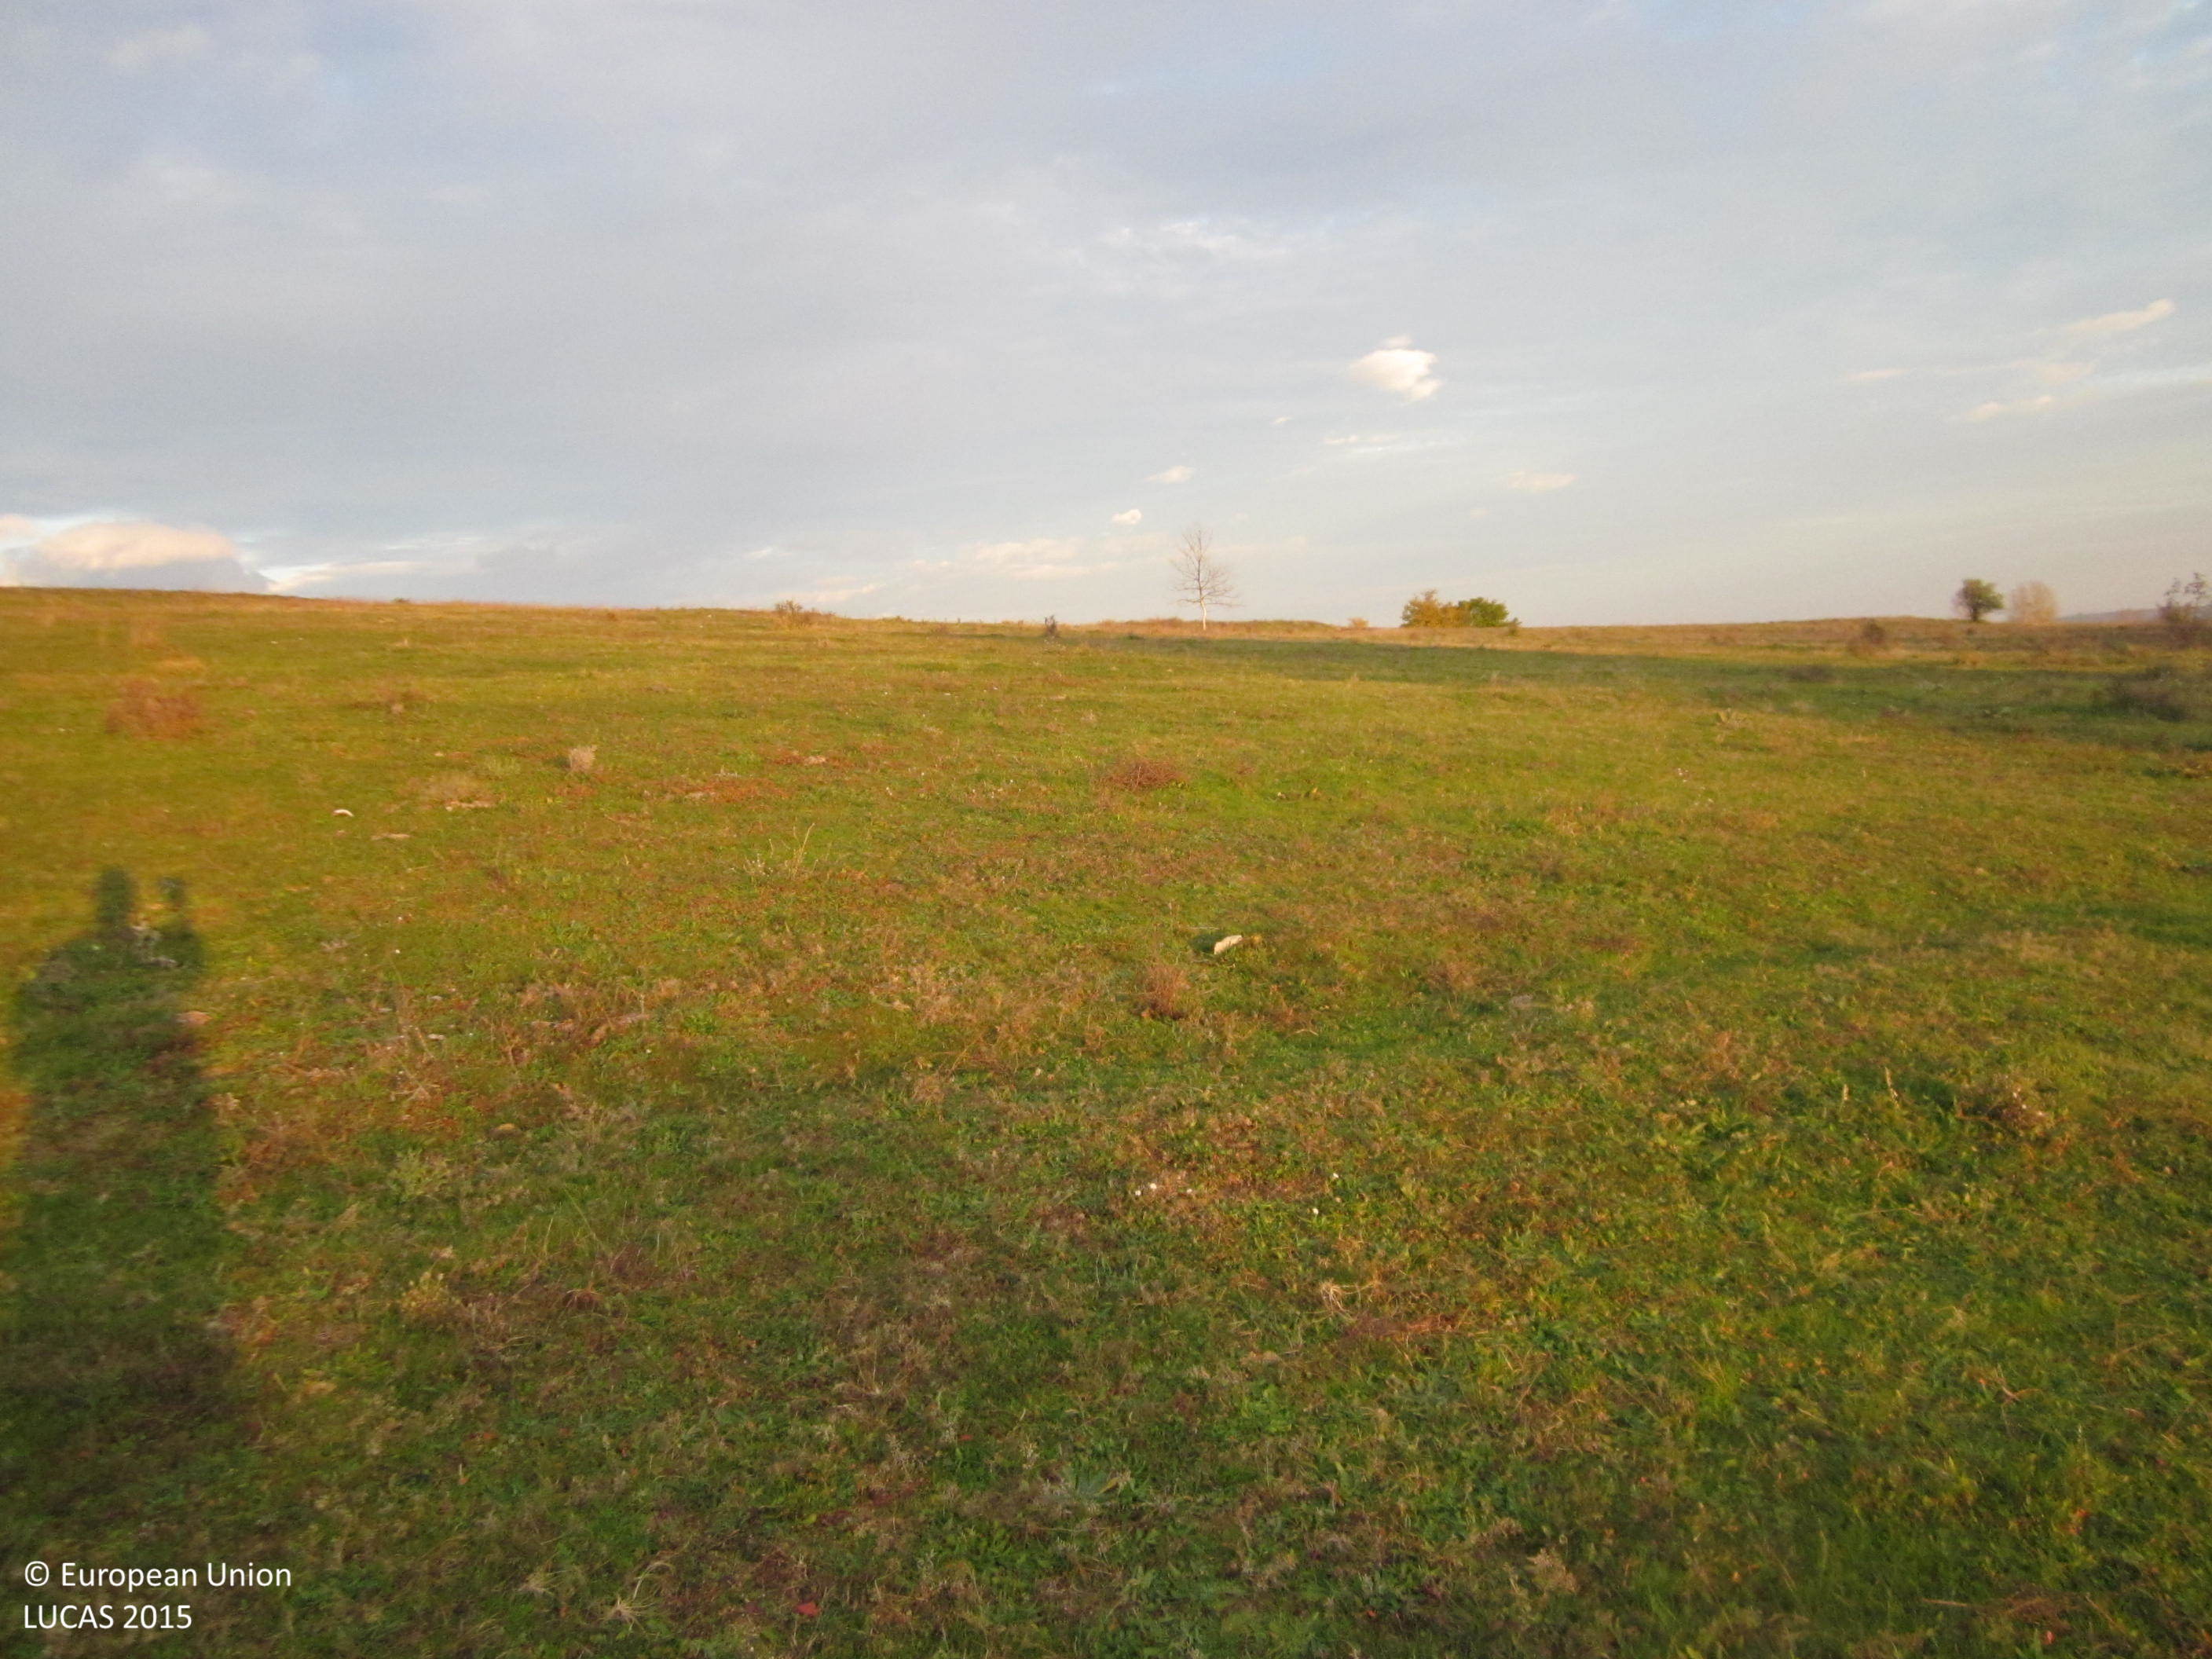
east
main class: Grassland
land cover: Grassland without tree/shrub cover
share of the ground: > 75 %
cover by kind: herbaceous plants 100 %
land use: Agriculture (excluding fallow land and kitchen gardens)
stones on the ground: < 10 %
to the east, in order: Grassland without tree/shrub cover; Tracks; Grass margins; Sunflower; Abandoned hedges; Grass margins; Sunflower
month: November
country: BG
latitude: 42.4639
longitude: 24.6347
